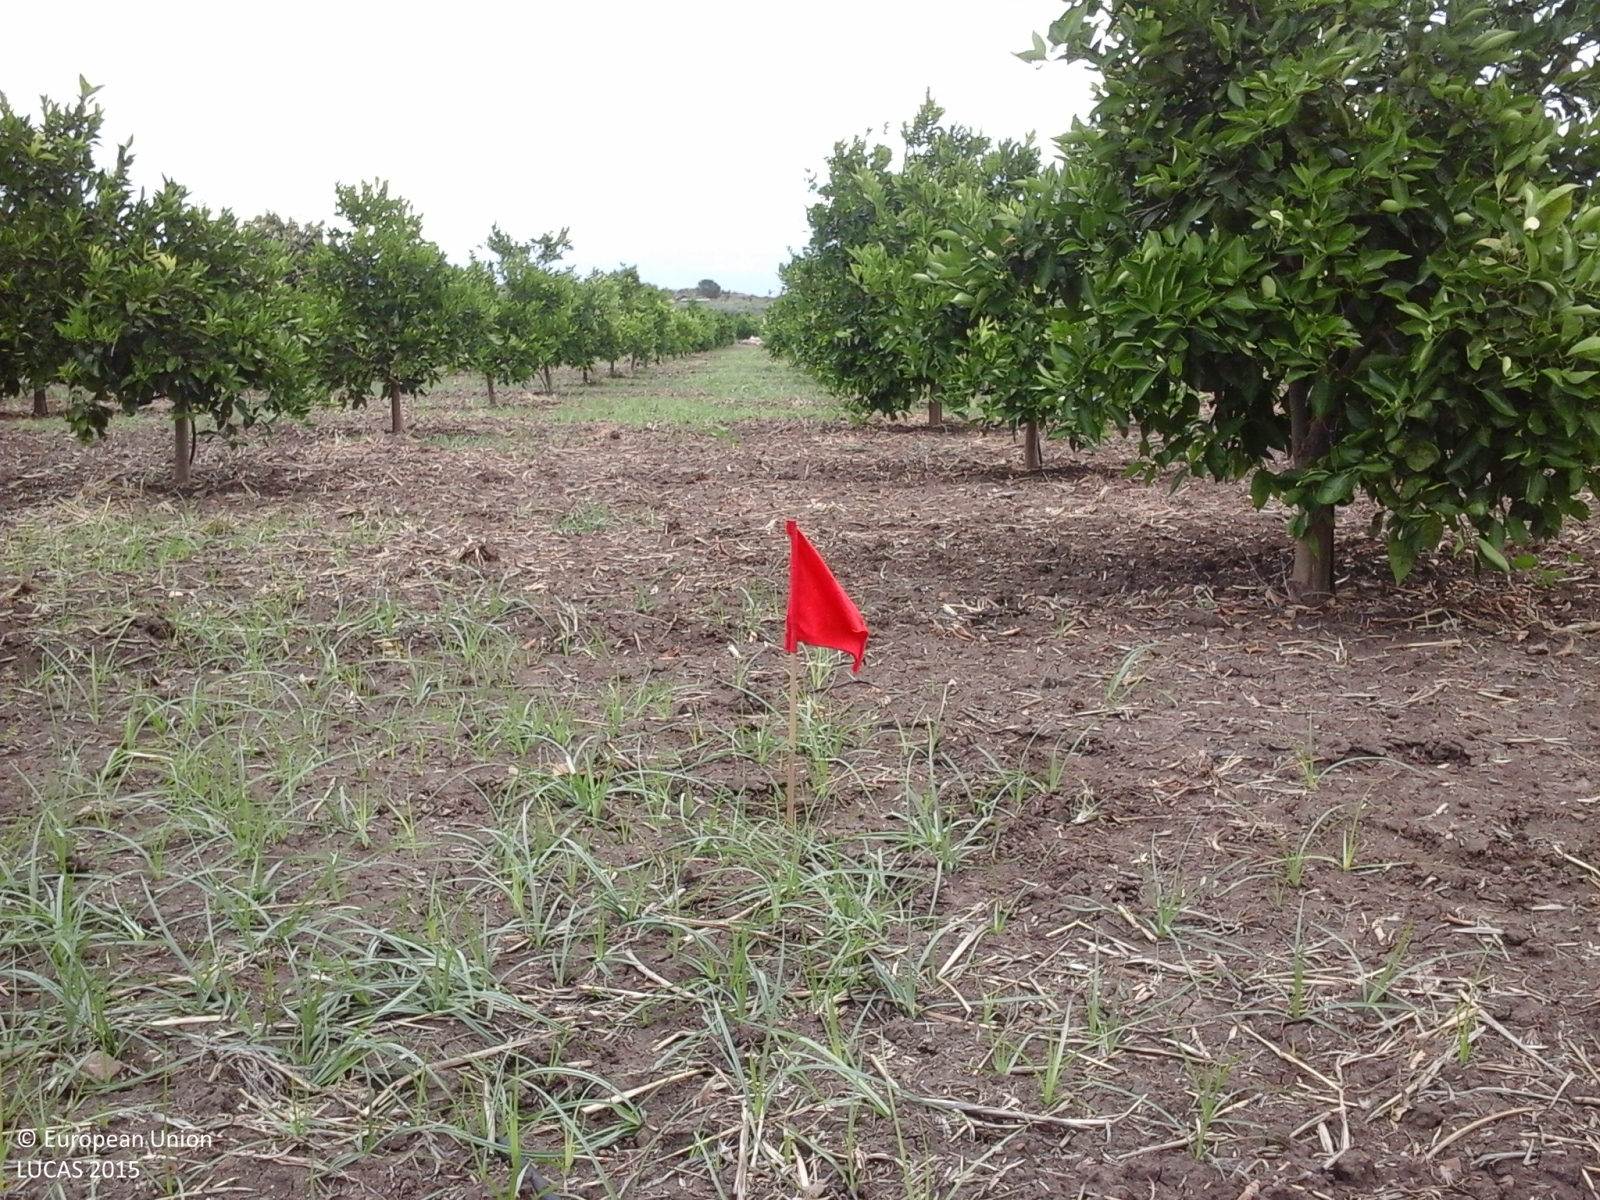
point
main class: Cropland
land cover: Oranges
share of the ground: > 75 %
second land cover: Spontaneously vegetated surfaces
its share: > 75 %
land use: Agriculture (excluding fallow land and kitchen gardens)
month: June
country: IT
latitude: 37.4970
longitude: 14.8399
